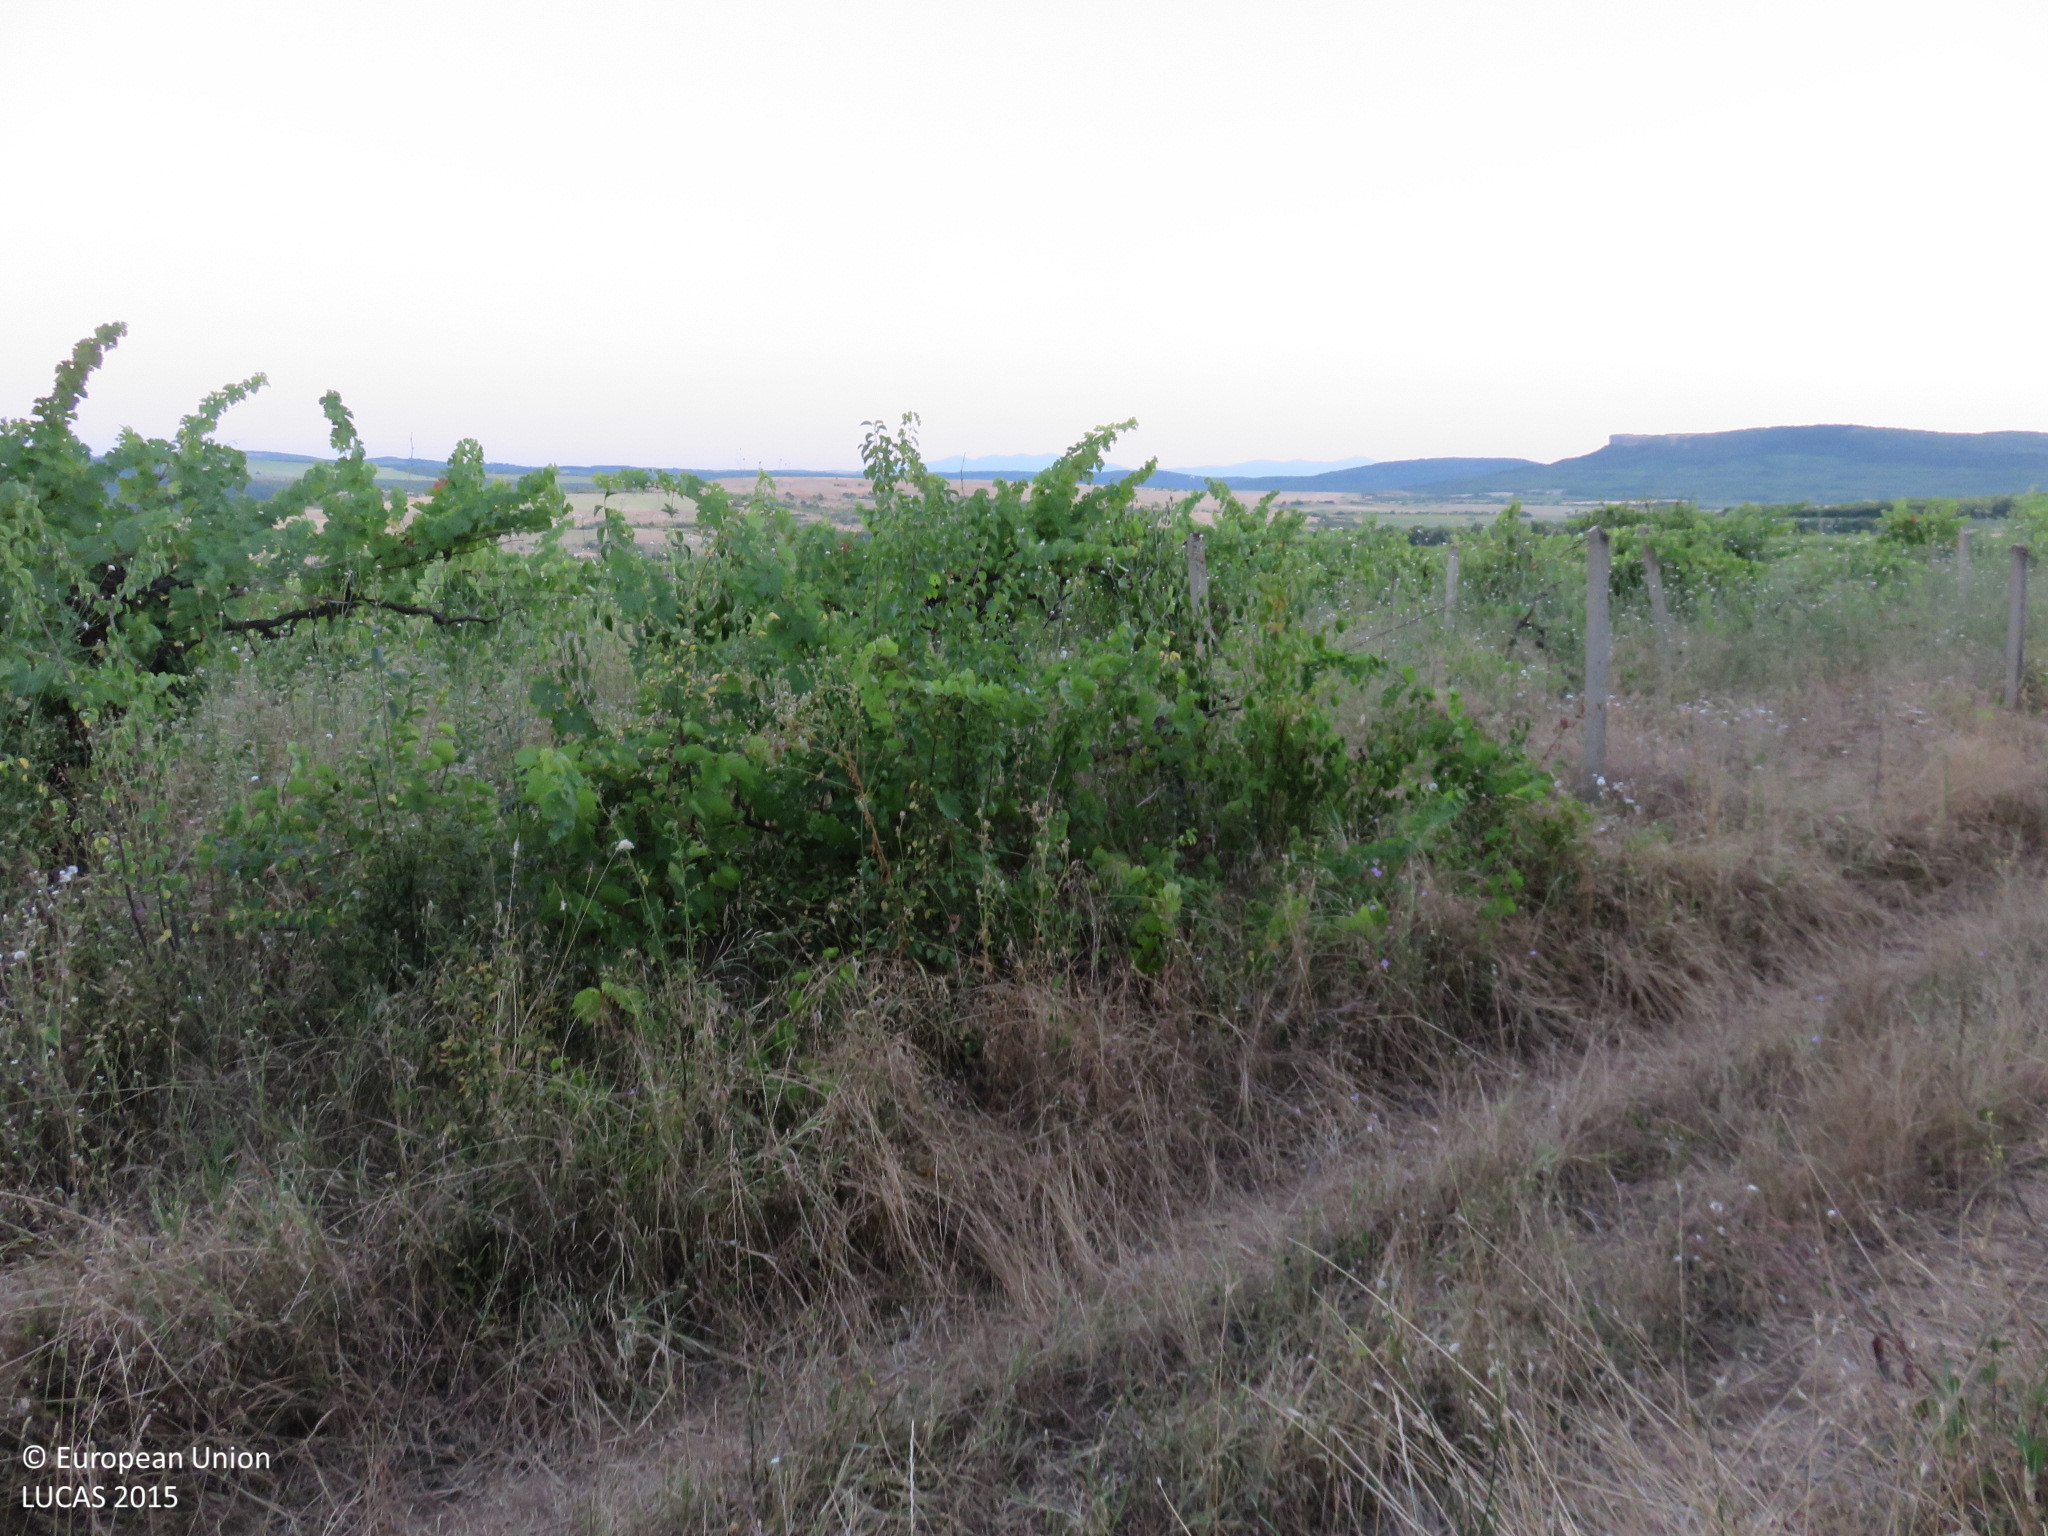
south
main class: Woodland
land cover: Broadleaved woodland
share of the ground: > 75 %
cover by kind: broadleaved forest trees 50 %, shrubs 50 %
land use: Semi-natural and natural areas not in use
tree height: > 5 m
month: July
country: BG
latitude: 43.1873
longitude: 25.1936
